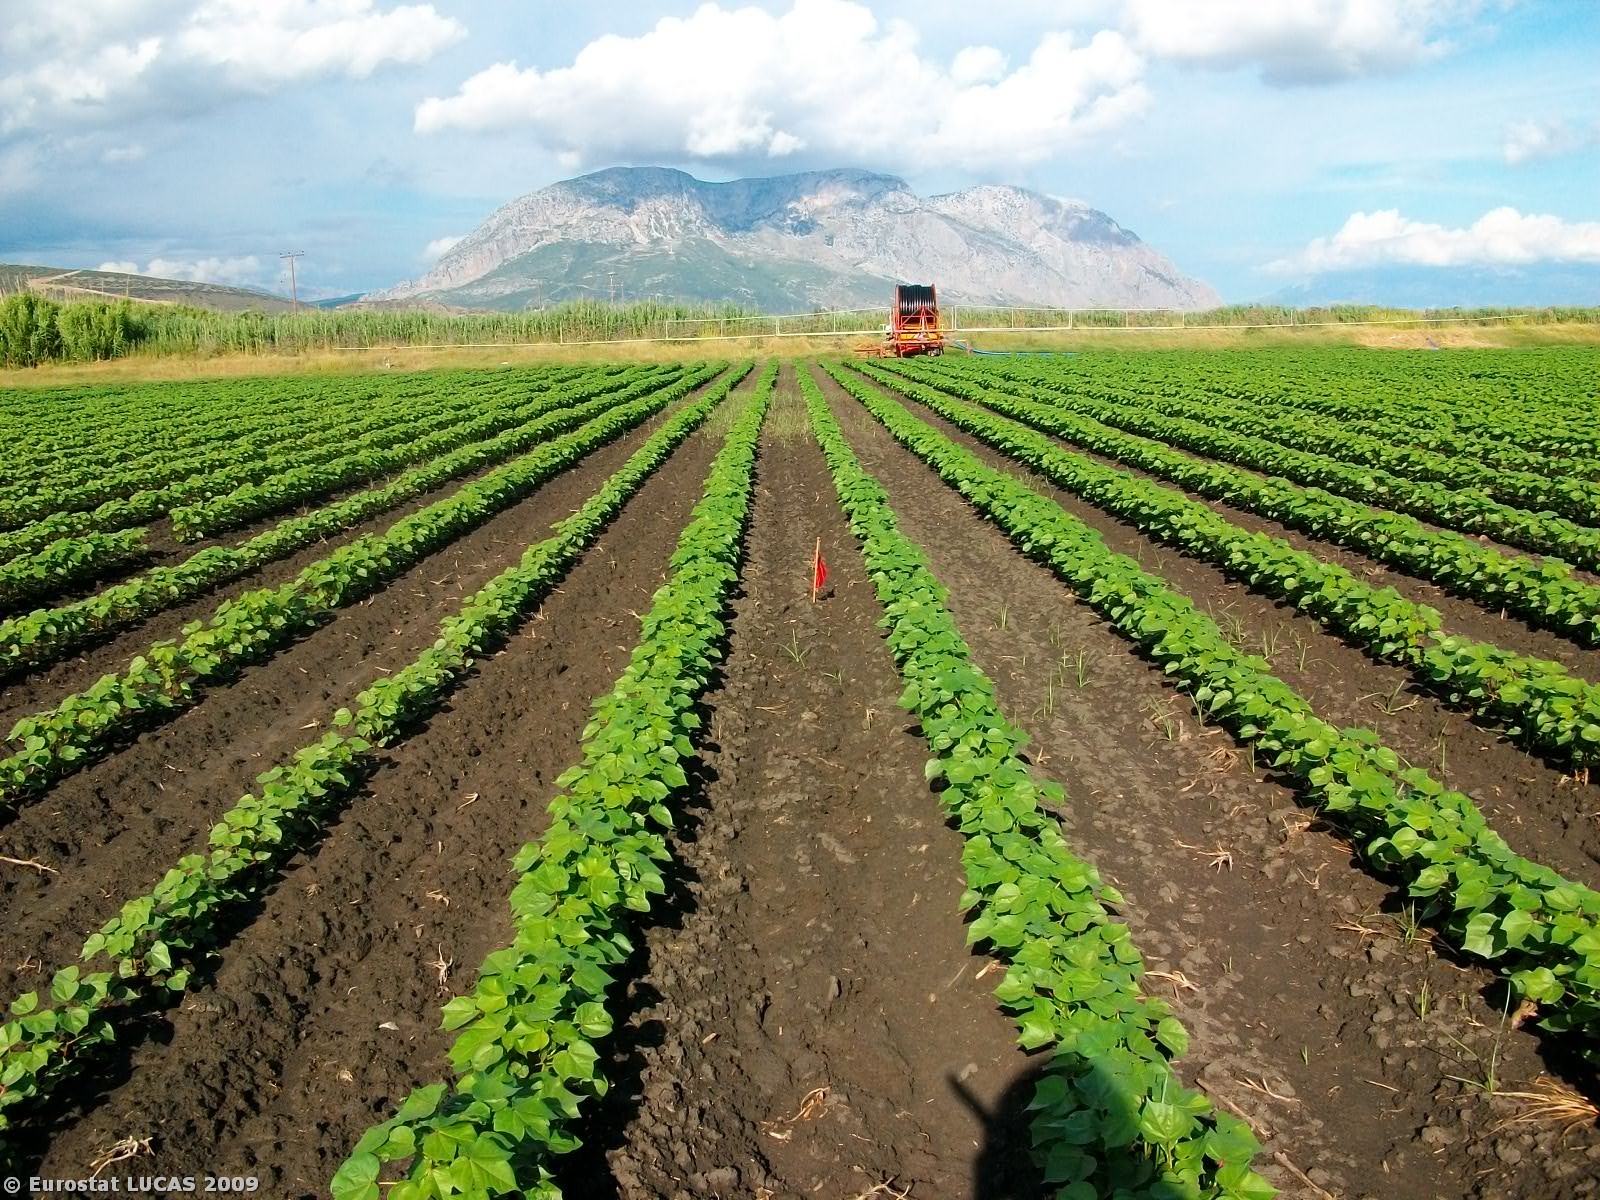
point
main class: Cropland
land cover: Cotton
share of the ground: 25 - 50 %
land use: Agriculture (excluding fallow land and kitchen gardens)
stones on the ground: < 10 %
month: June
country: GR
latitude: 38.3654
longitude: 21.4926
